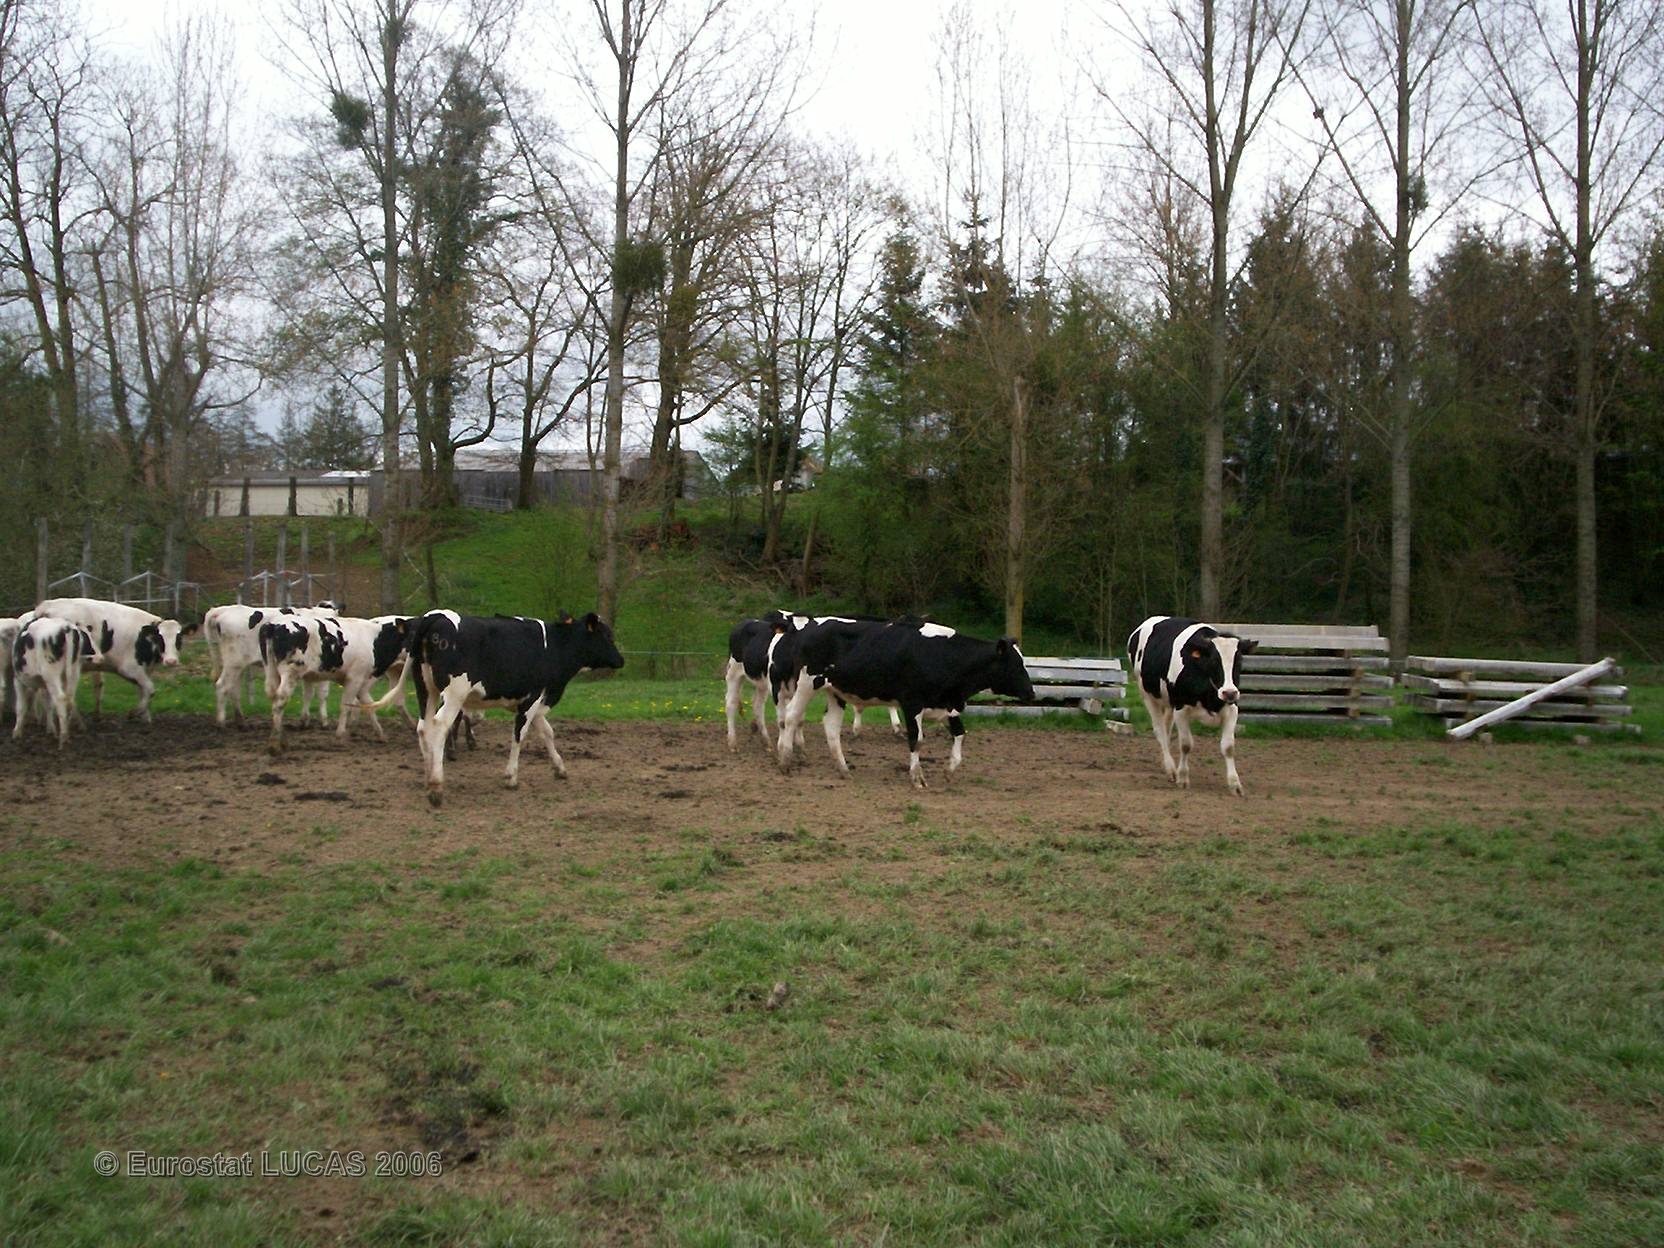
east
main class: Grassland
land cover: Grassland without tree/shrub cover
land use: Agriculture (excluding fallow land and kitchen gardens)
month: April
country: FR
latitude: 48.7146
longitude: -0.3495
